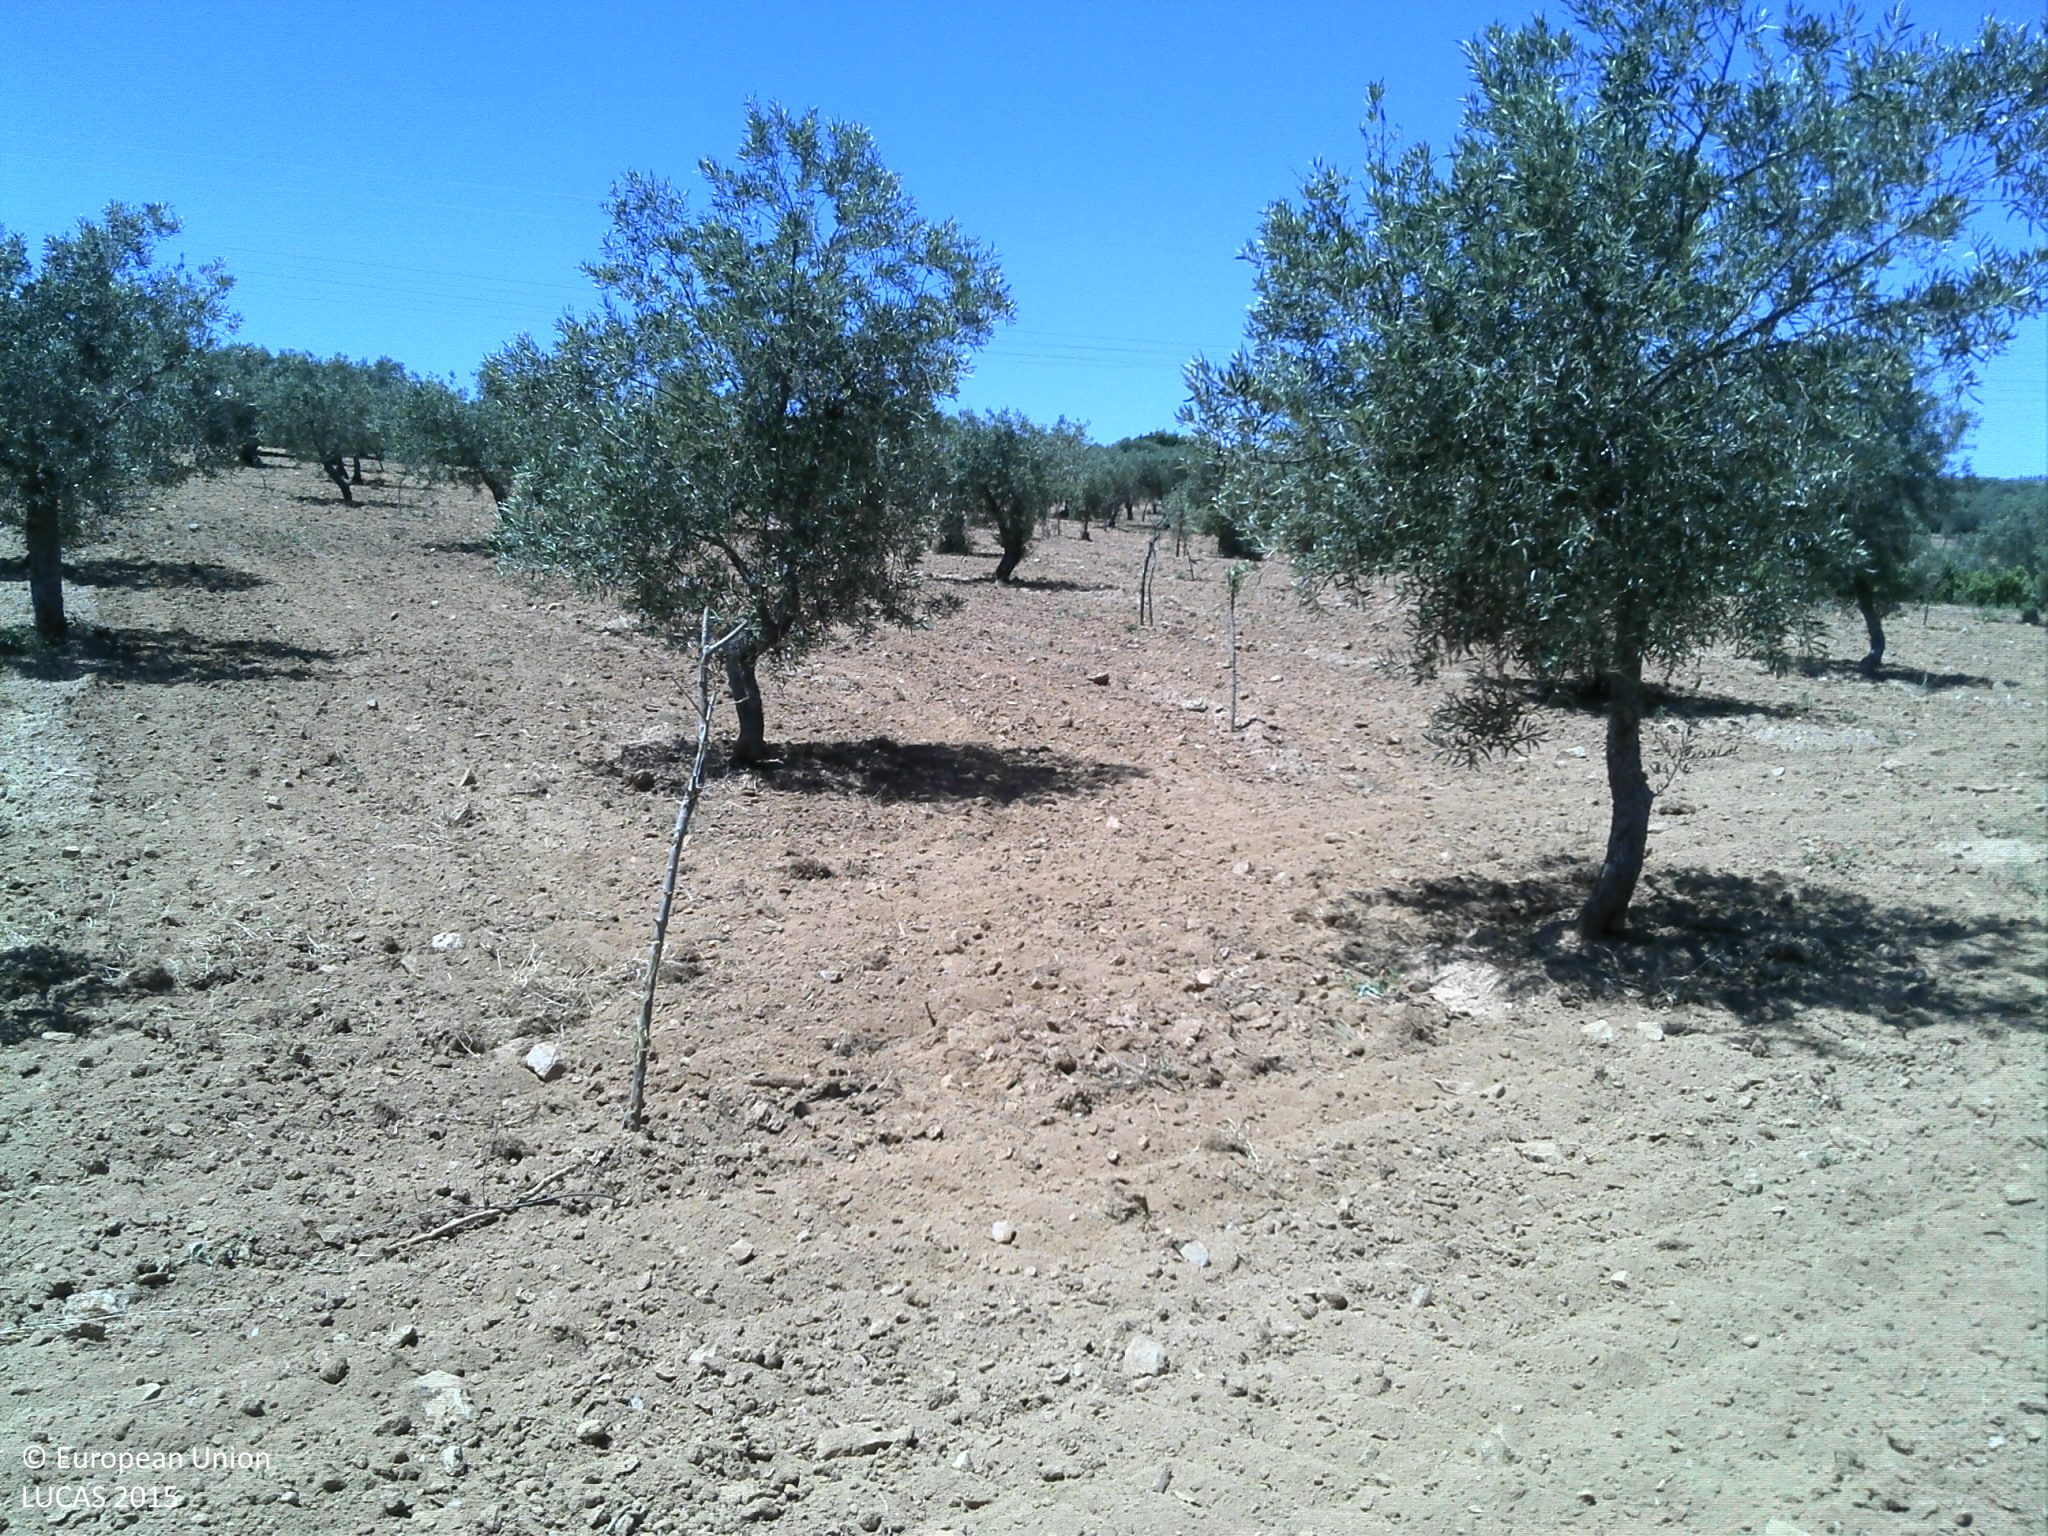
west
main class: Cropland
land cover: Olive groves
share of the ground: 25 - 50 %
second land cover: Other bare soil
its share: > 75 %
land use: Agriculture (excluding fallow land and kitchen gardens)
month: June
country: PT
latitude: 40.8041
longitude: -7.2864
